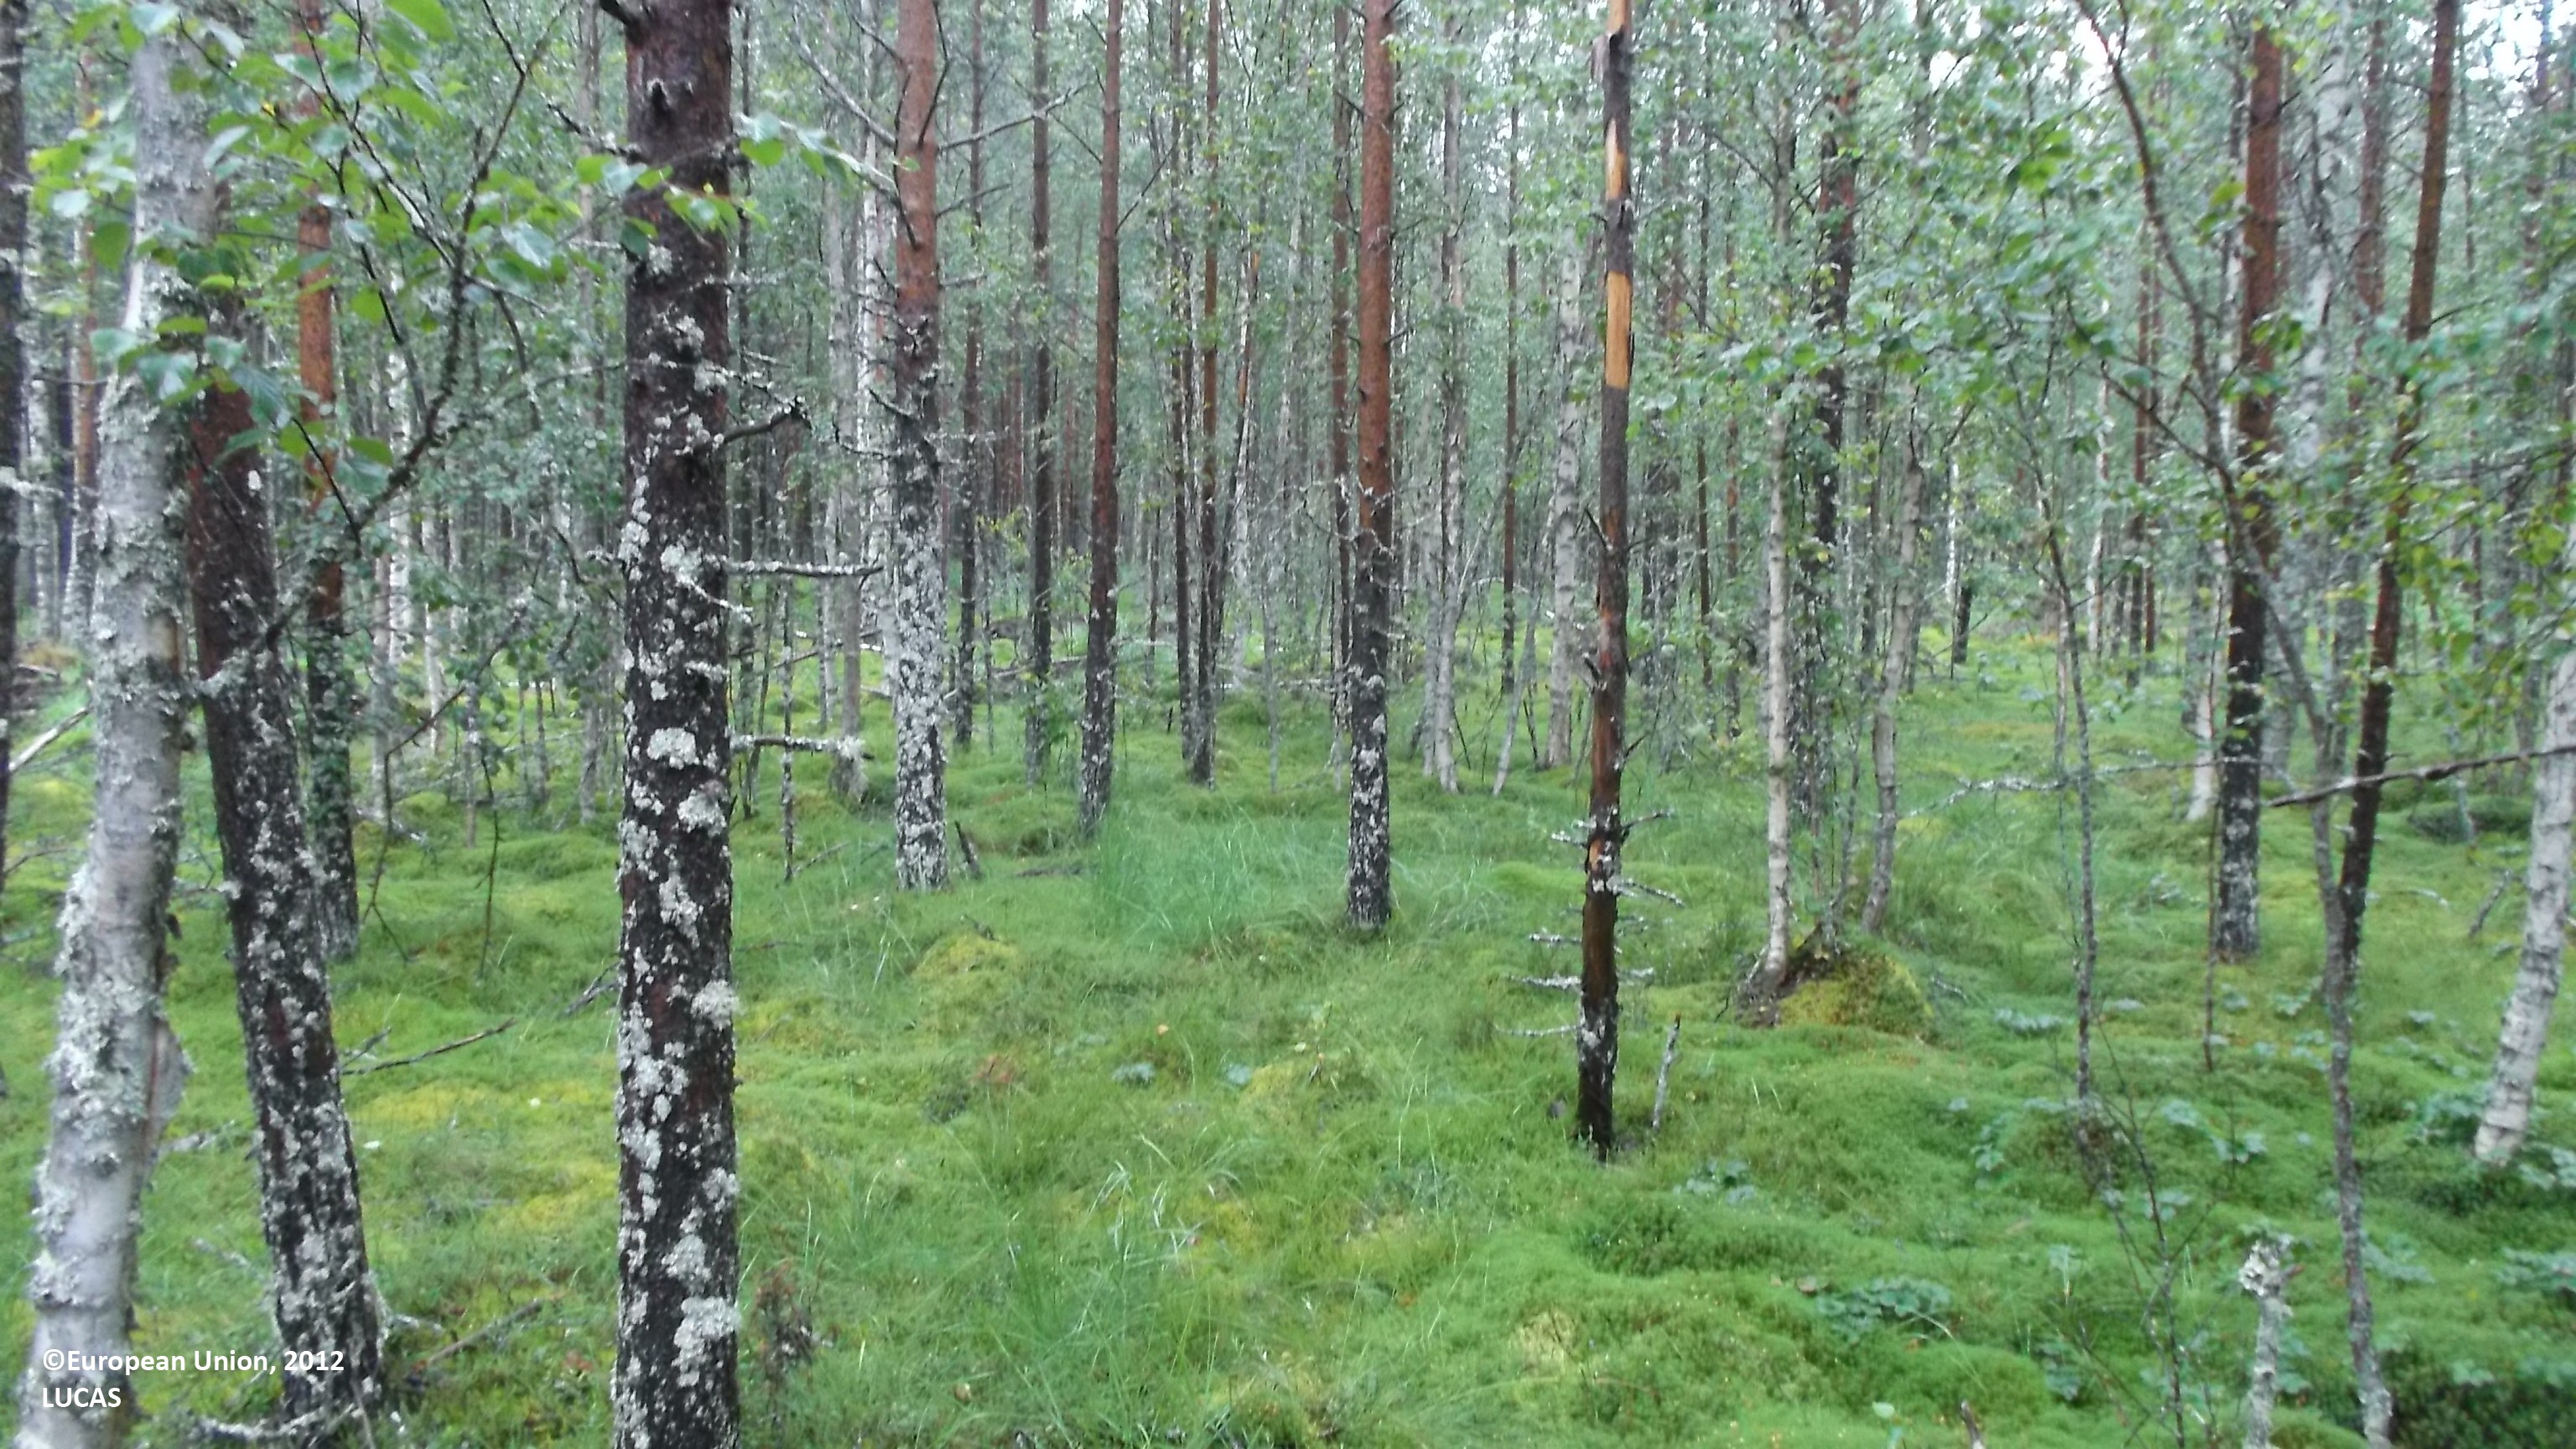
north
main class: Woodland
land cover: Other mixed woodland
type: mire and swamp forests
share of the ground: 50 - 75 %
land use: Forestry
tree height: > 5 m
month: August
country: FI
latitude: 63.3281
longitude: 24.4374
